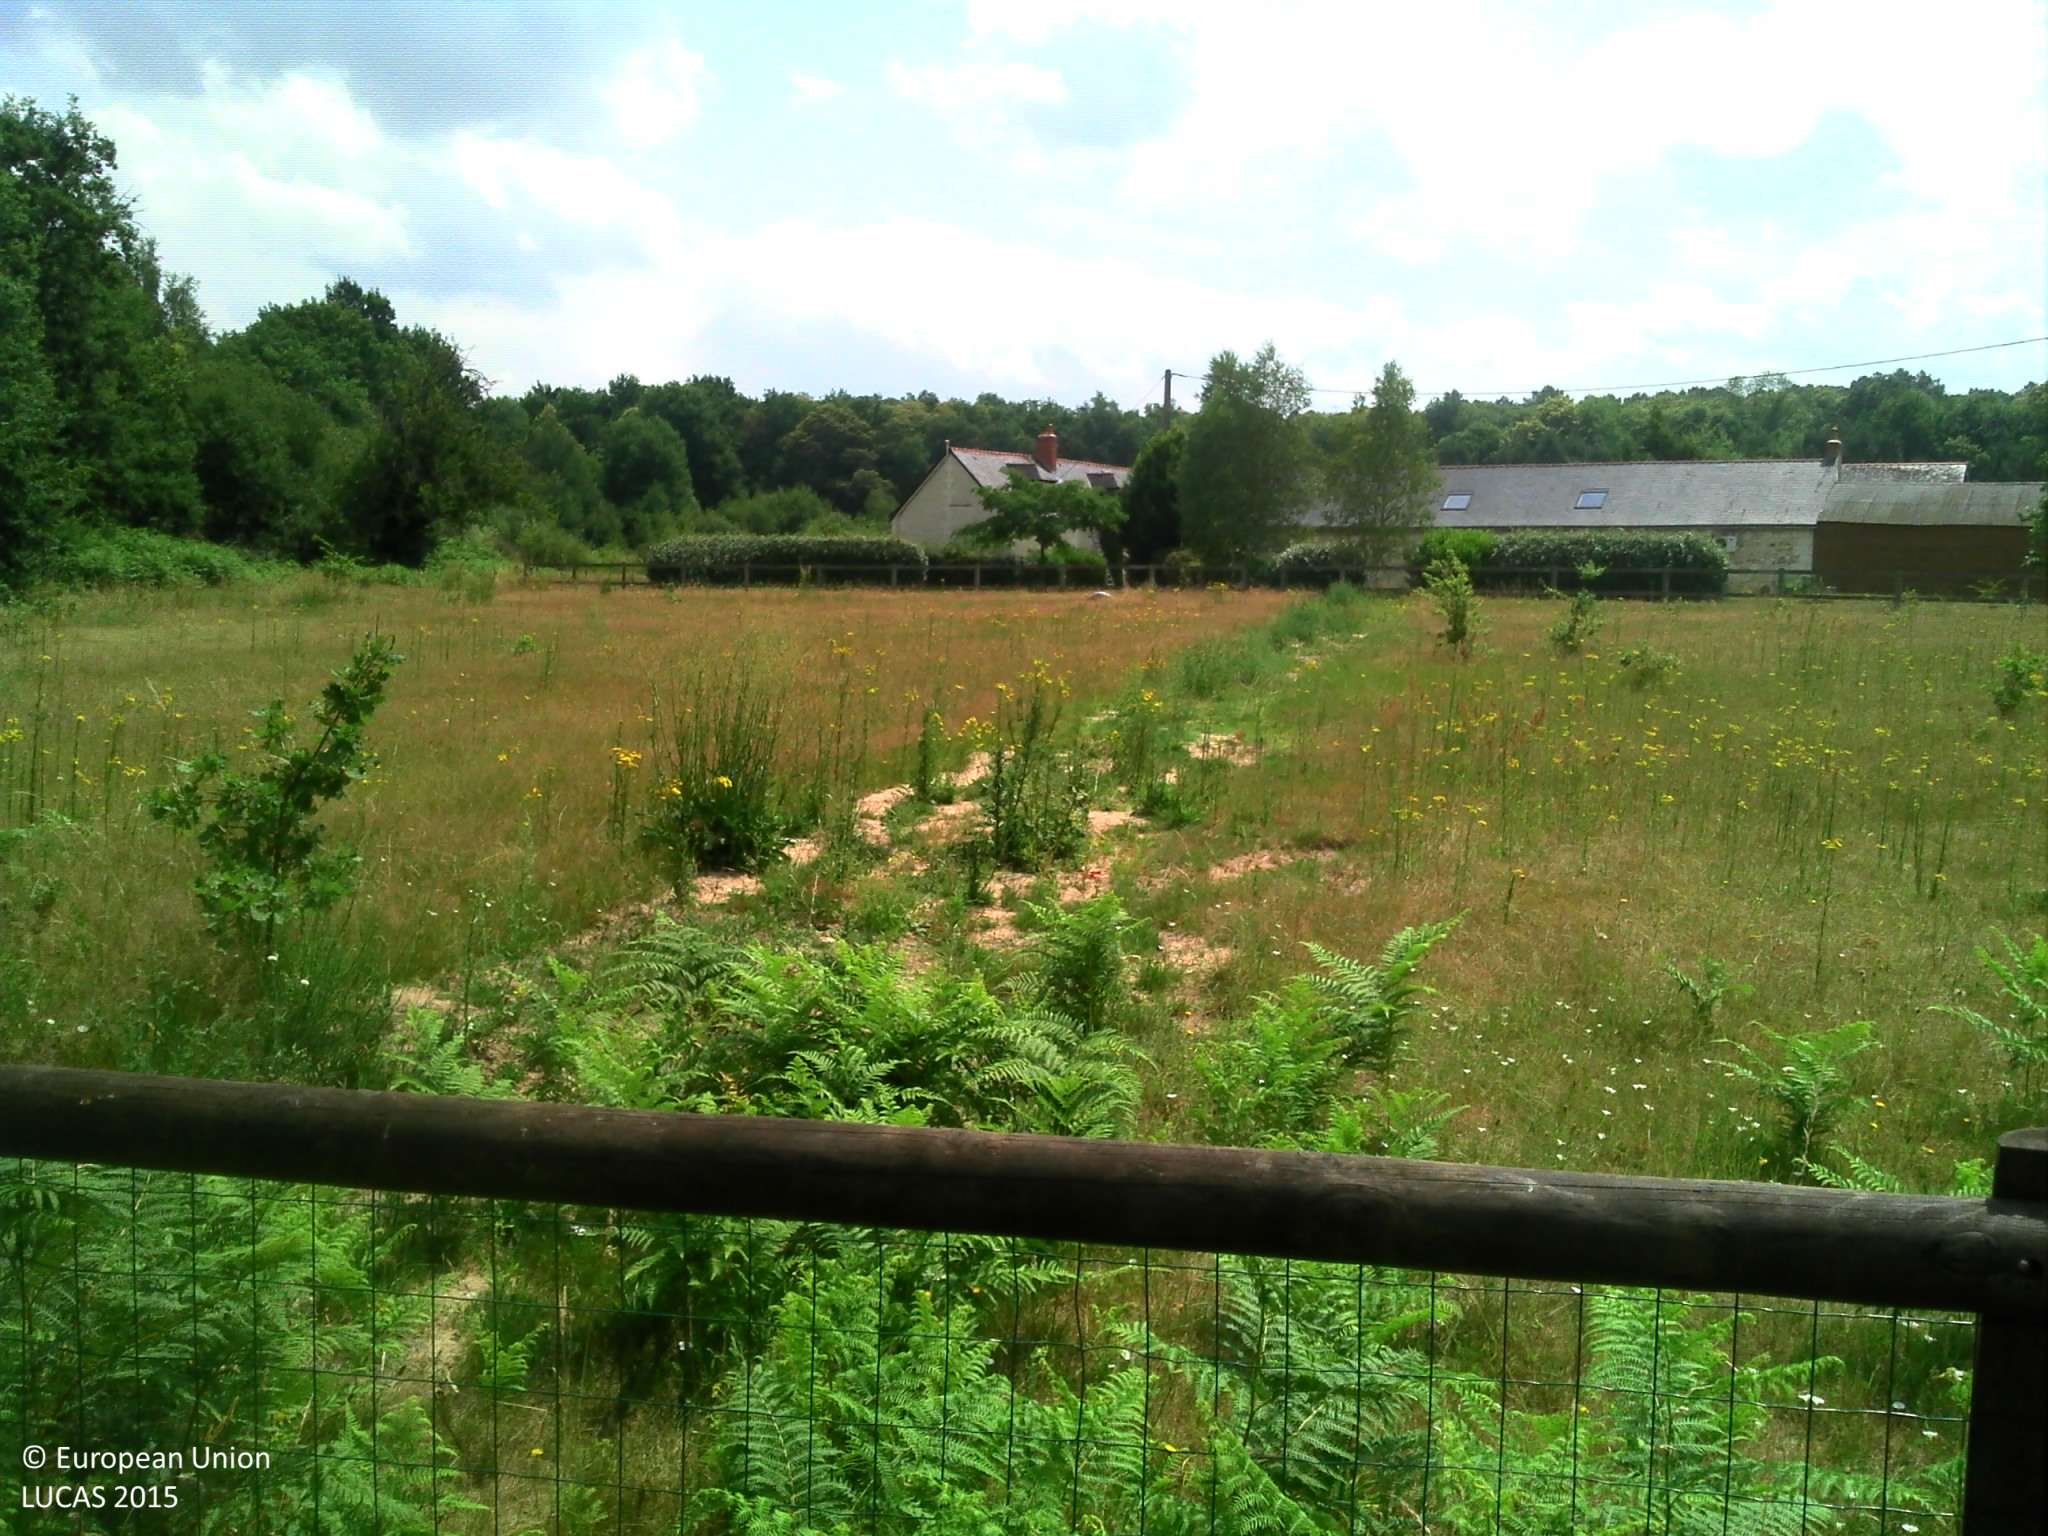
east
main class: Grassland
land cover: Grassland without tree/shrub cover
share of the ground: > 75 %
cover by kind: herbaceous plants 100 %
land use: Agriculture (excluding fallow land and kitchen gardens)
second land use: Residential
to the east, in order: Grassland without tree/shrub cover; Fences; Broadleaved woodland; Ponds and wetlands; Fences; Broadleaved woodland; Ditches and canals; Grass margins; Paved roads, cycling and walking lanes; Grass margins; Ditches and canals; Broadleaved woodland; Ditches and canals; Broadleaved woodland
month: July
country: FR
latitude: 47.3253
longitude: 0.1184
